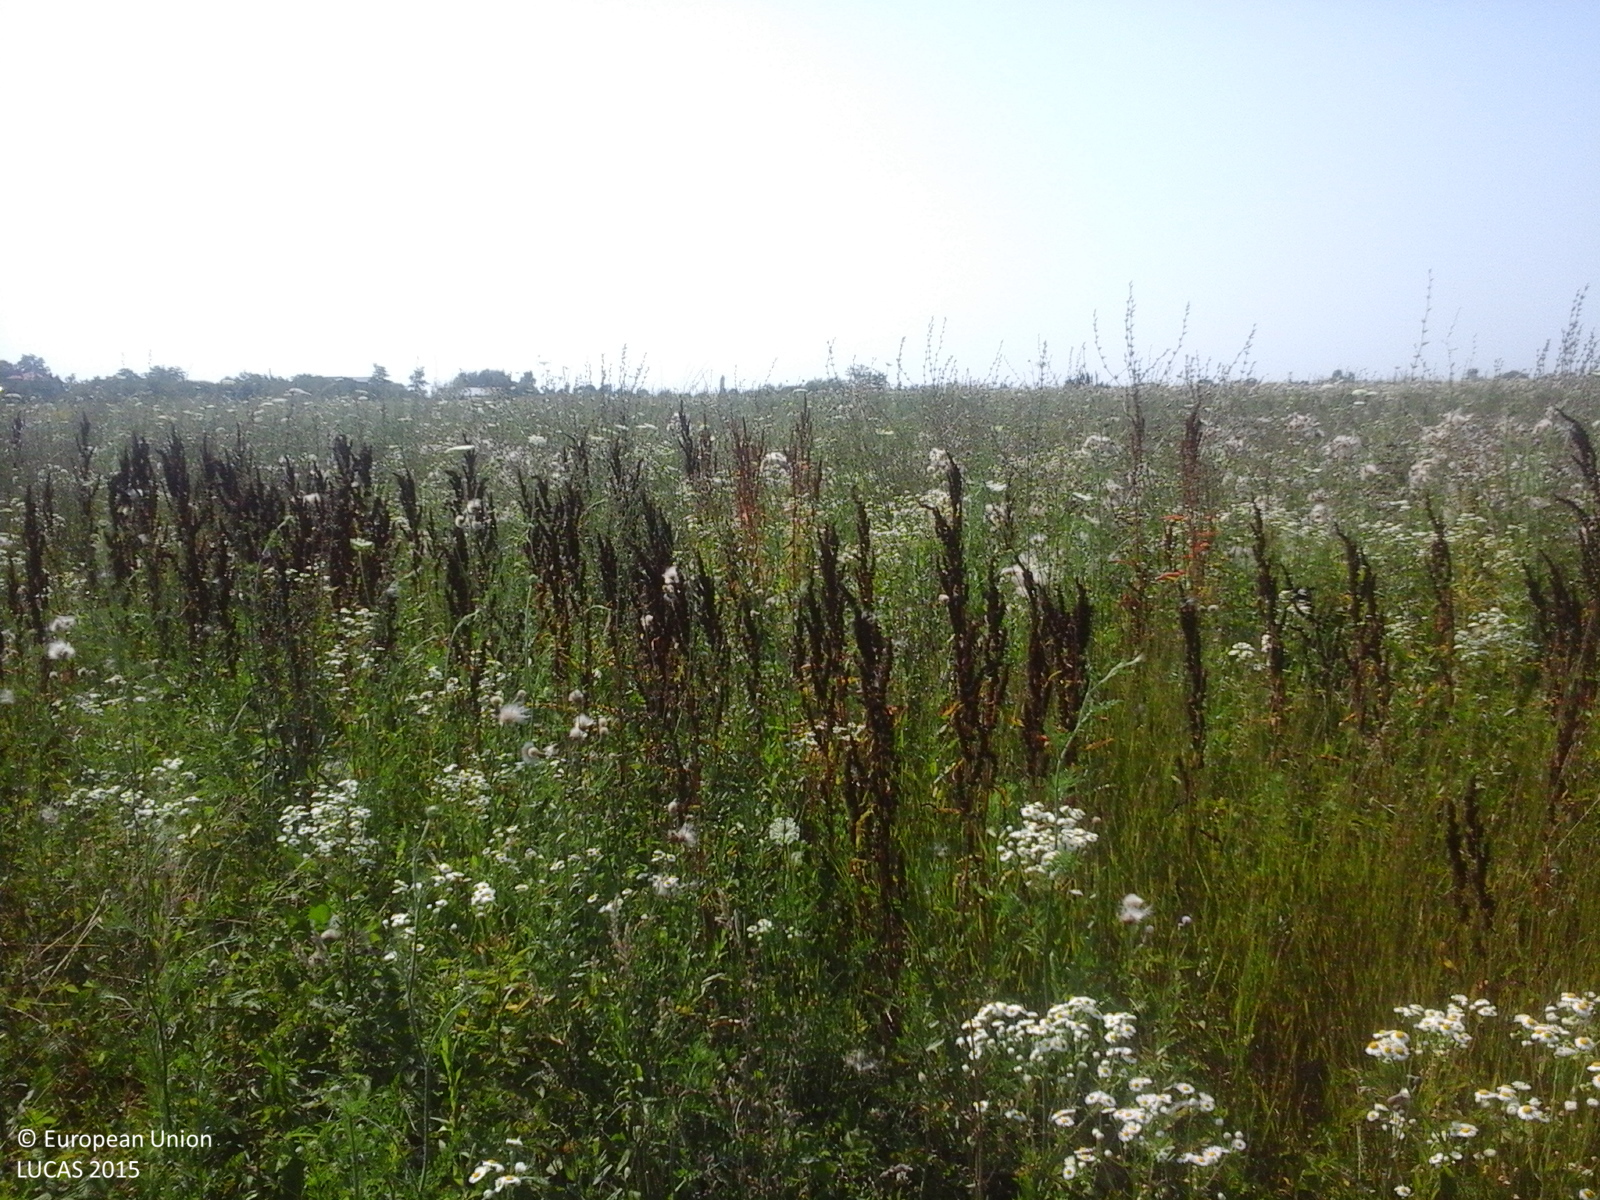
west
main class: Grassland
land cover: Spontaneously vegetated surfaces
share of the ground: > 75 %
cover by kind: herbaceous plants 100 %
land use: Fallow land
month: July
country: RO
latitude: 44.6750
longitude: 25.4186
